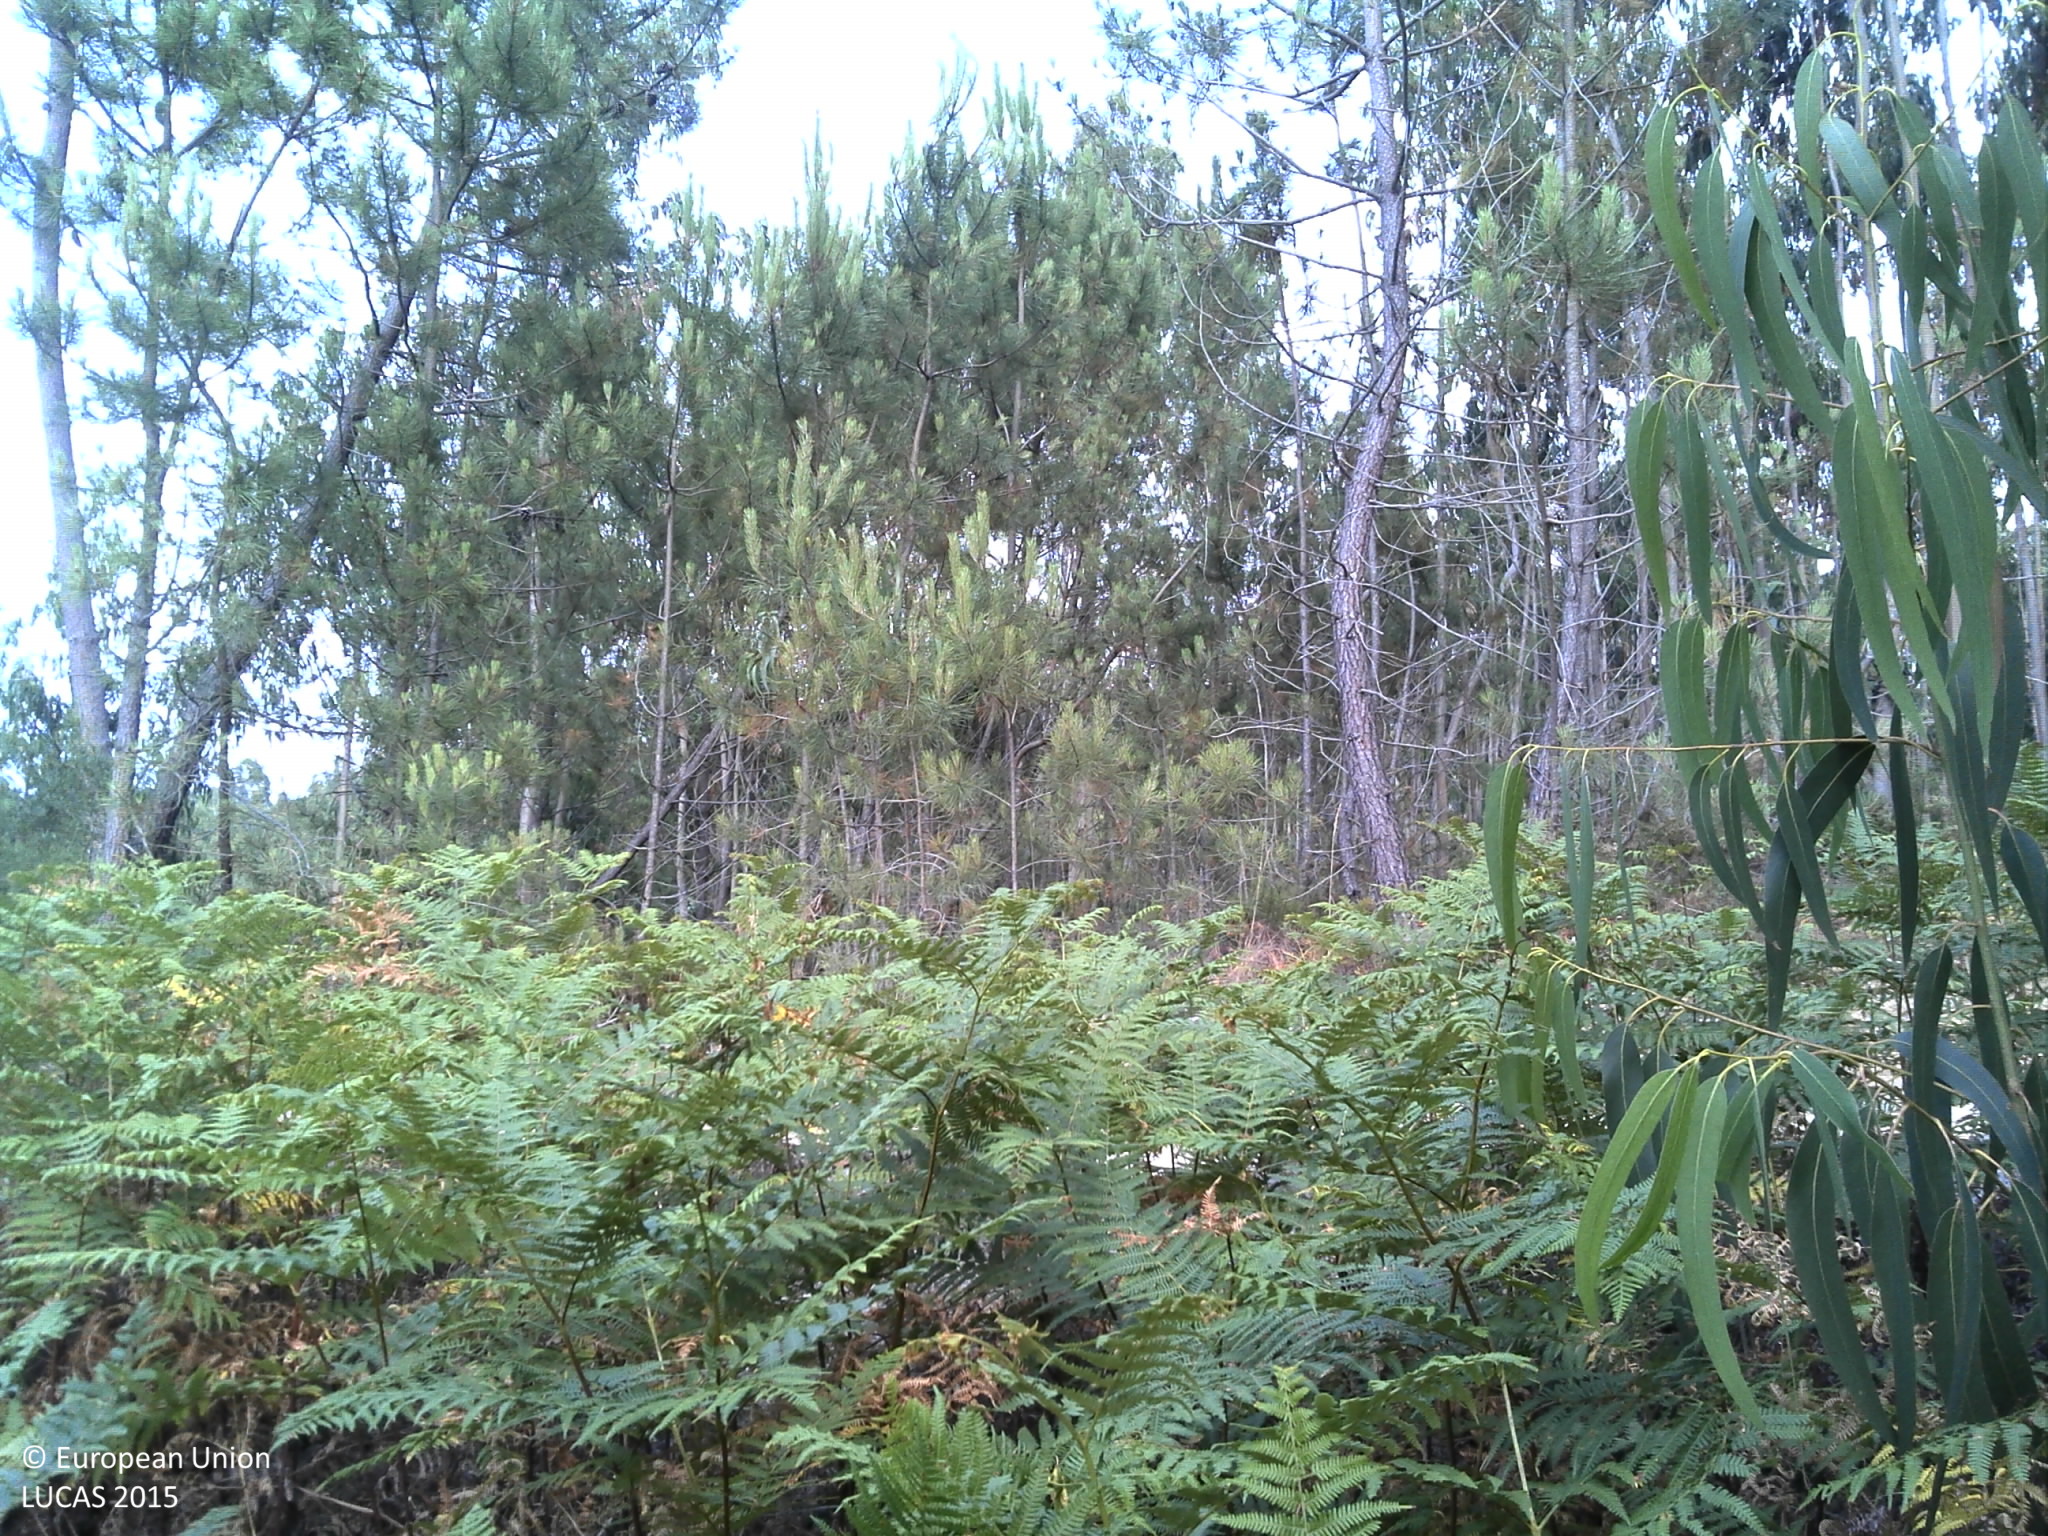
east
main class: Woodland
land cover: Pine dominated coniferous woodland
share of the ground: 50 - 75 %
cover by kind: coniferous forest trees 60 %, shrubs 20 %, unconsolidated bare surface 10 %, broadleaved forest trees 5 %, herbaceous plants 5 %
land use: Forestry
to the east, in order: Pine dominated coniferous woodland; Tracks; Pine dominated coniferous woodland; Broadleaved woodland
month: June
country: PT
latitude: 39.3641
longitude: -9.2298
